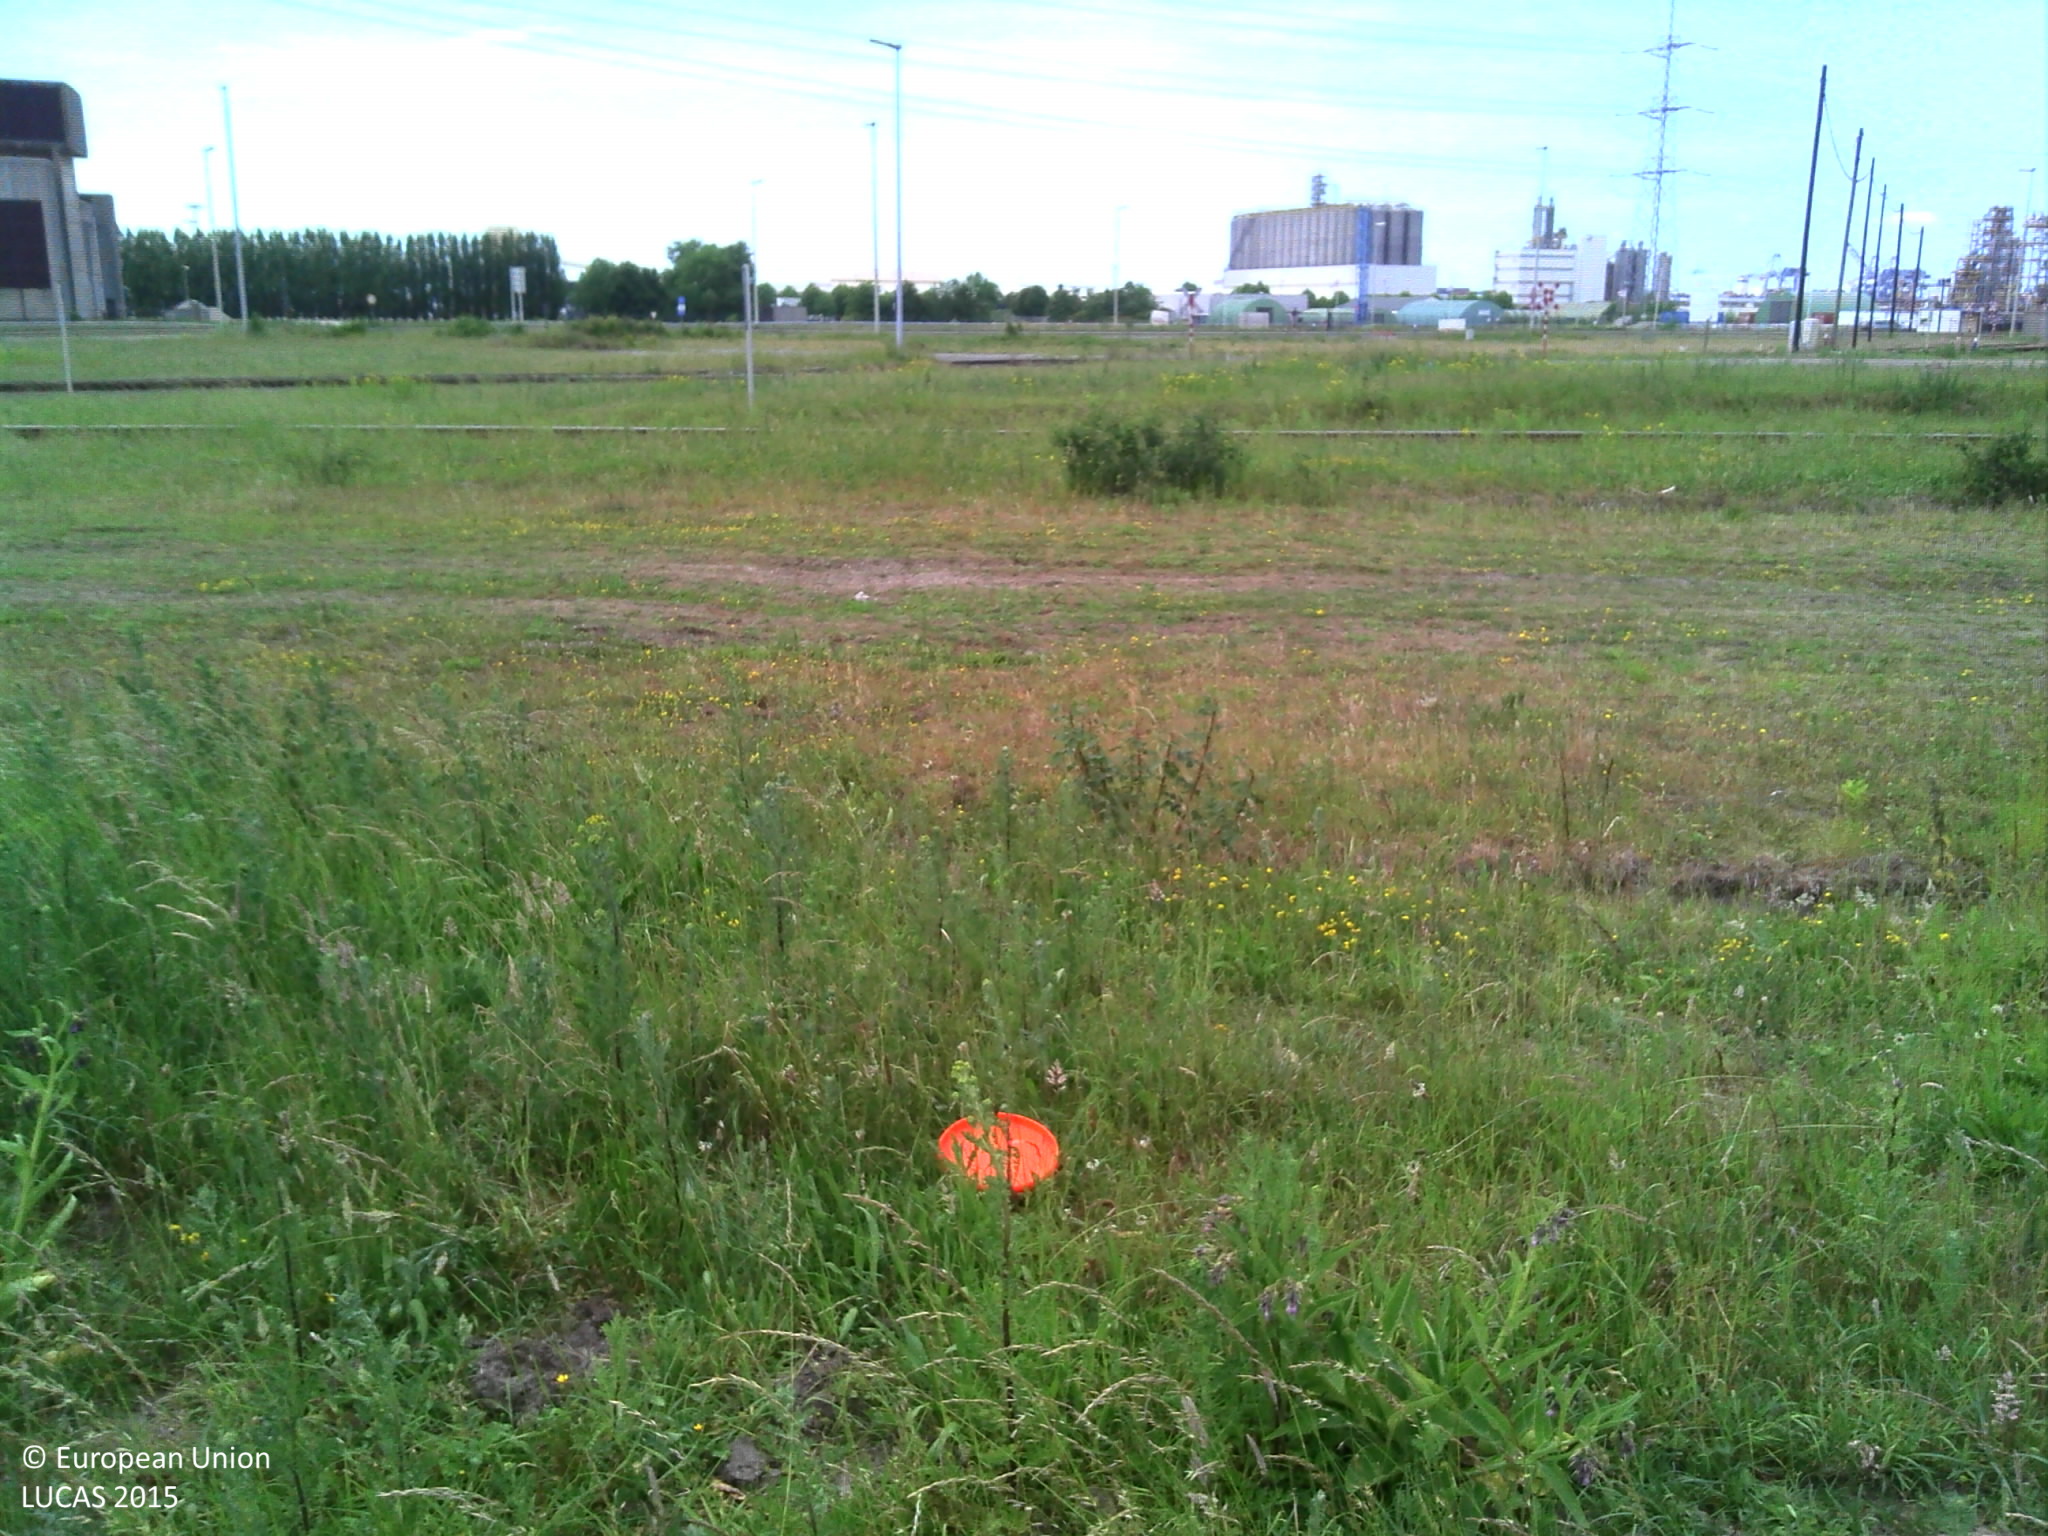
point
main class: Grassland
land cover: Spontaneously vegetated surfaces
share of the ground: > 75 %
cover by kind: herbaceous plants 100 %
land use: Semi-natural and natural areas not in use
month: June
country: BE
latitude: 51.2662
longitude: 4.2766
